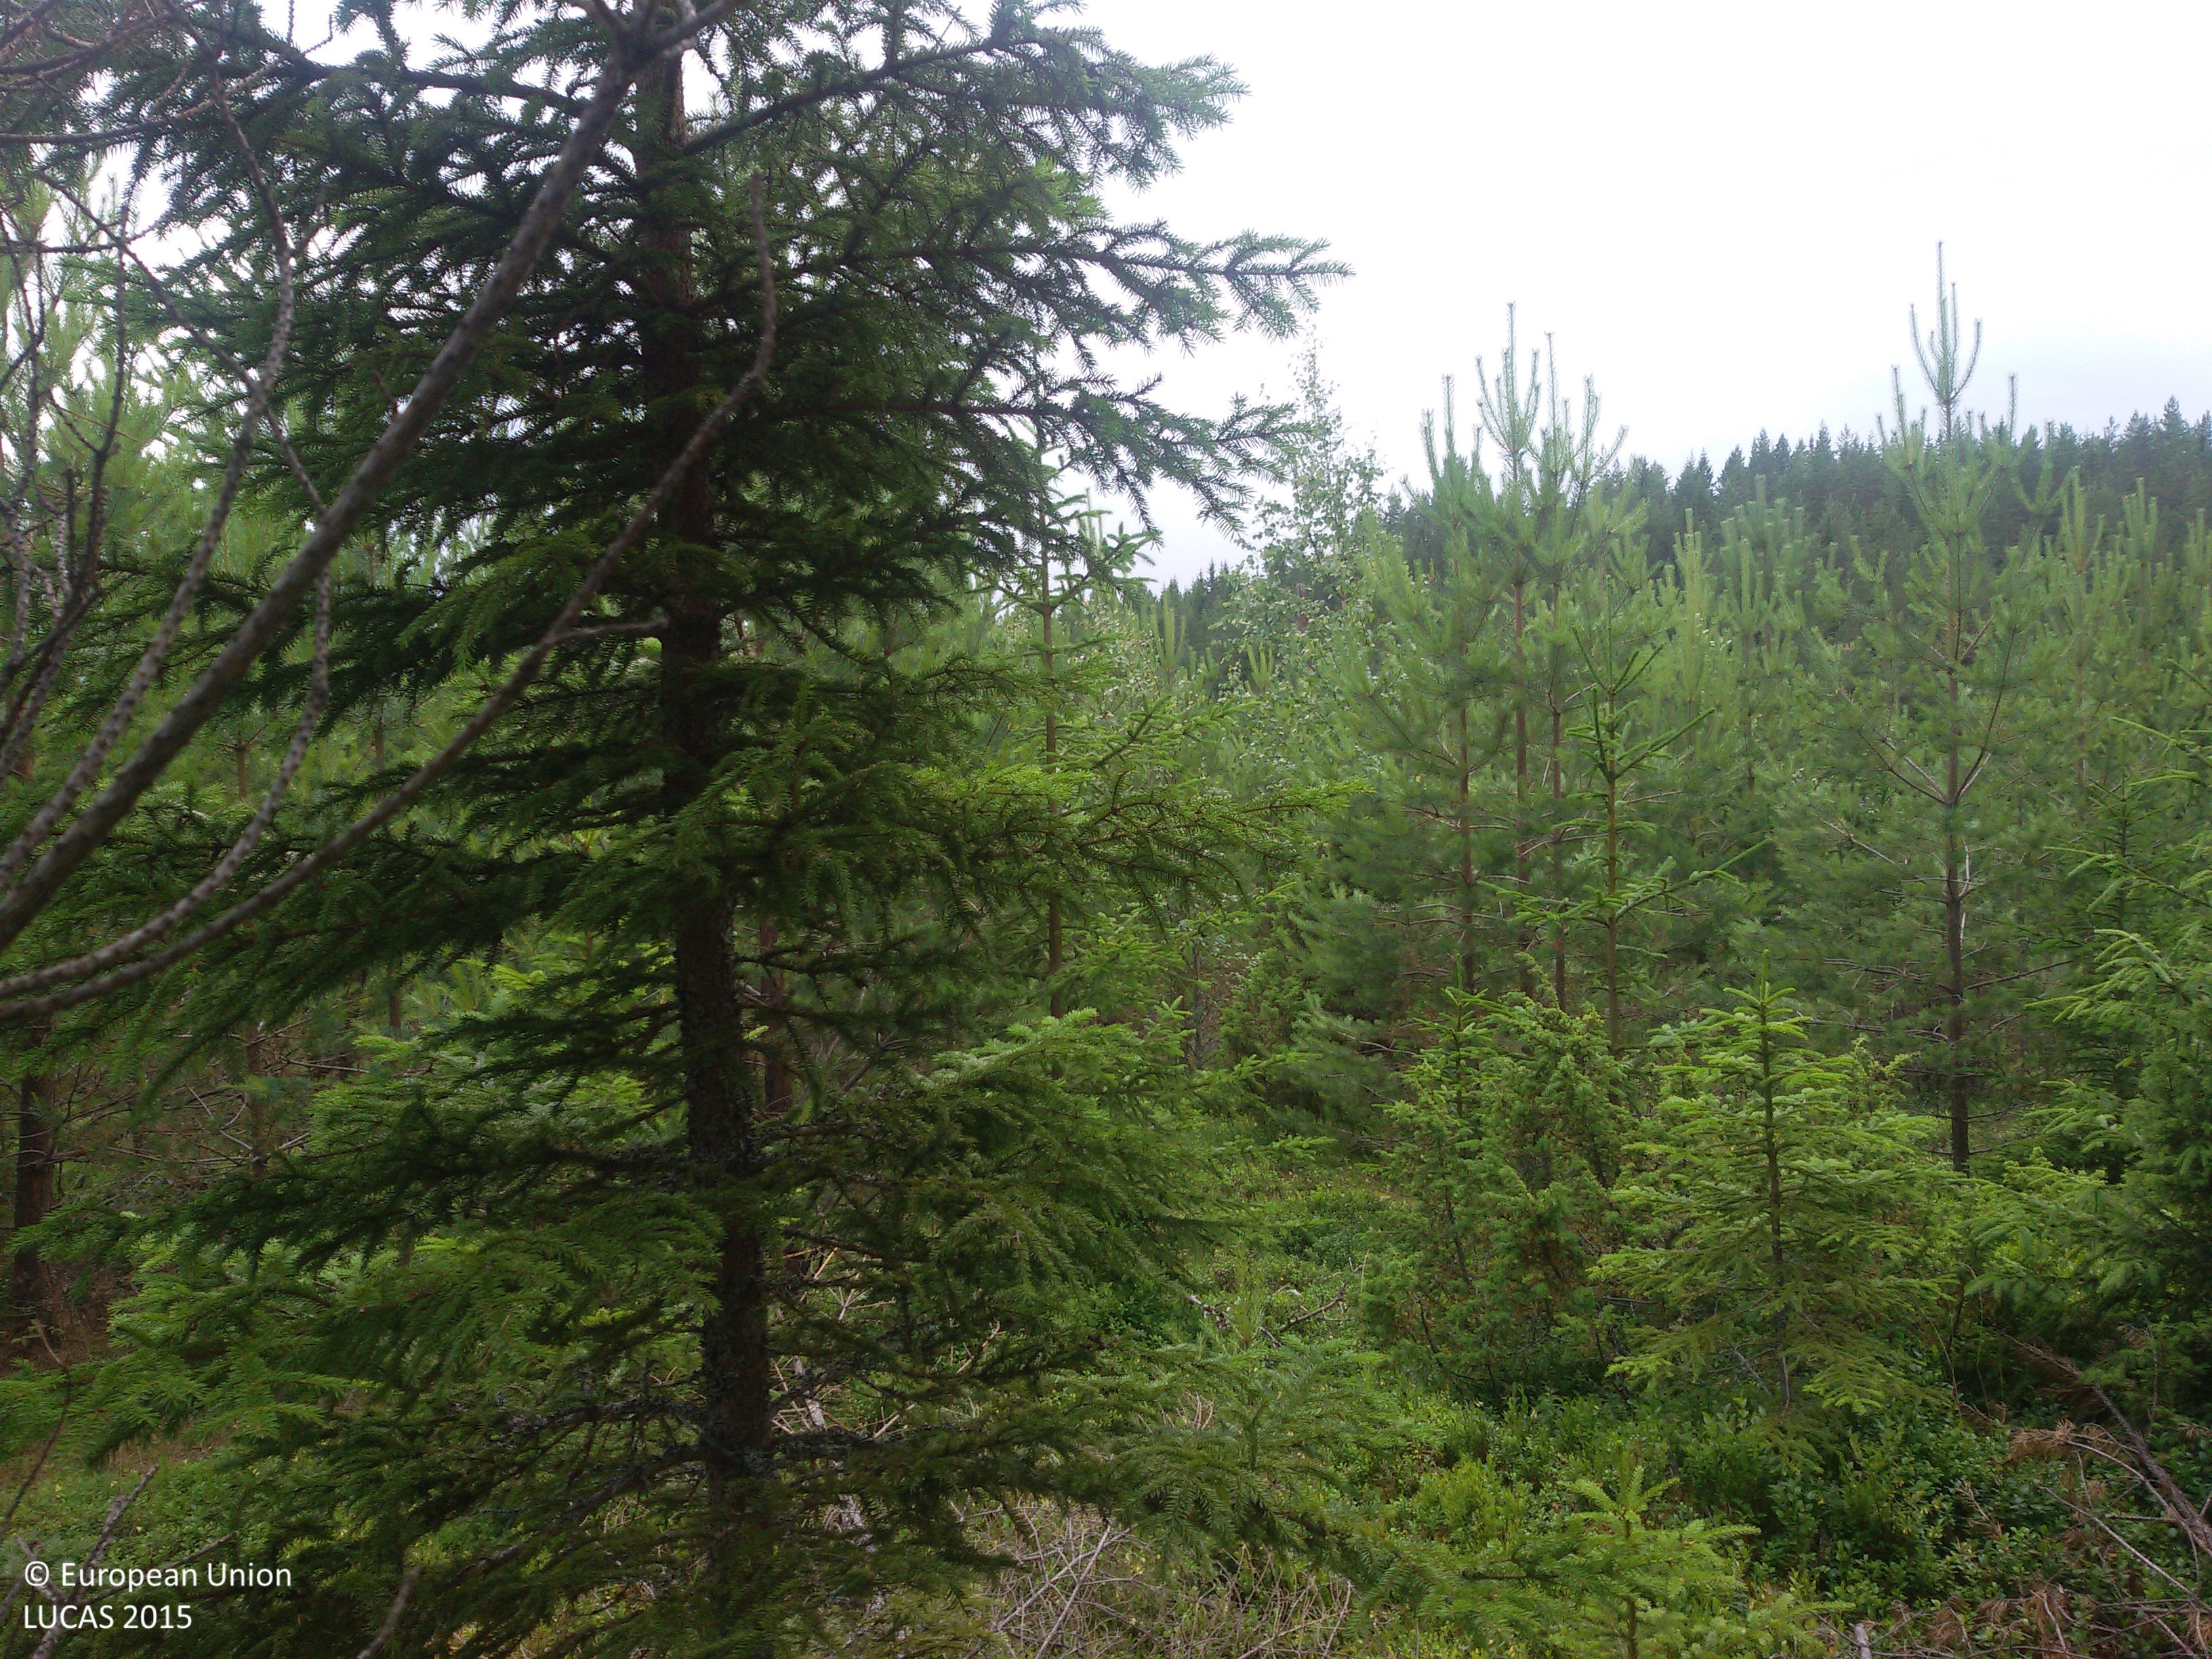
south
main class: Woodland
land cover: Pine dominated coniferous woodland
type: boreal forest
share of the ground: > 75 %
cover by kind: coniferous forest trees 80 %, herbaceous plants 20 %
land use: Forestry
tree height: > 5 m
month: July
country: SE
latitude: 60.5905
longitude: 15.1905
